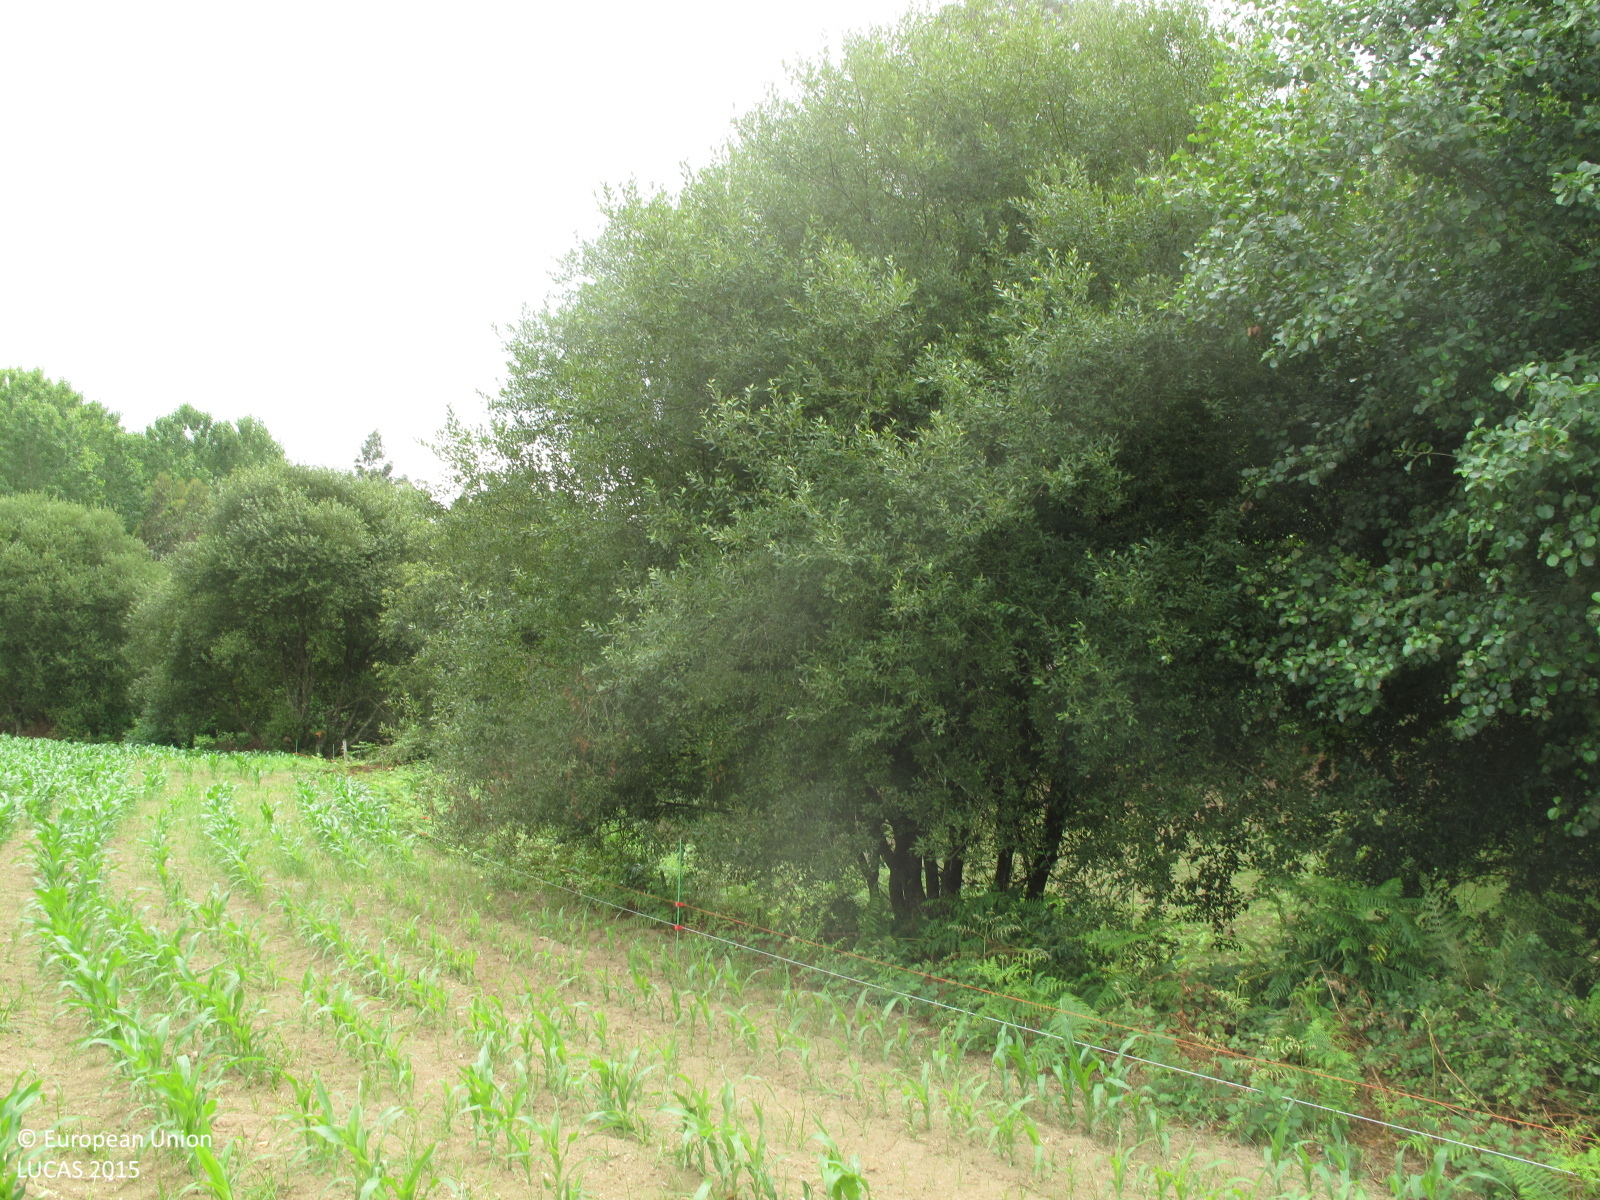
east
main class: Cropland
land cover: Maize
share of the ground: 25 - 50 %
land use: Agriculture (excluding fallow land and kitchen gardens)
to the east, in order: Maize; Broadleaved woodland; Fences; Shrubland with sparse tree cover; Fences; Broadleaved woodland; Other mixed woodland; Broadleaved woodland
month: July
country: ES
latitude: 43.4957
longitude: -8.1177
